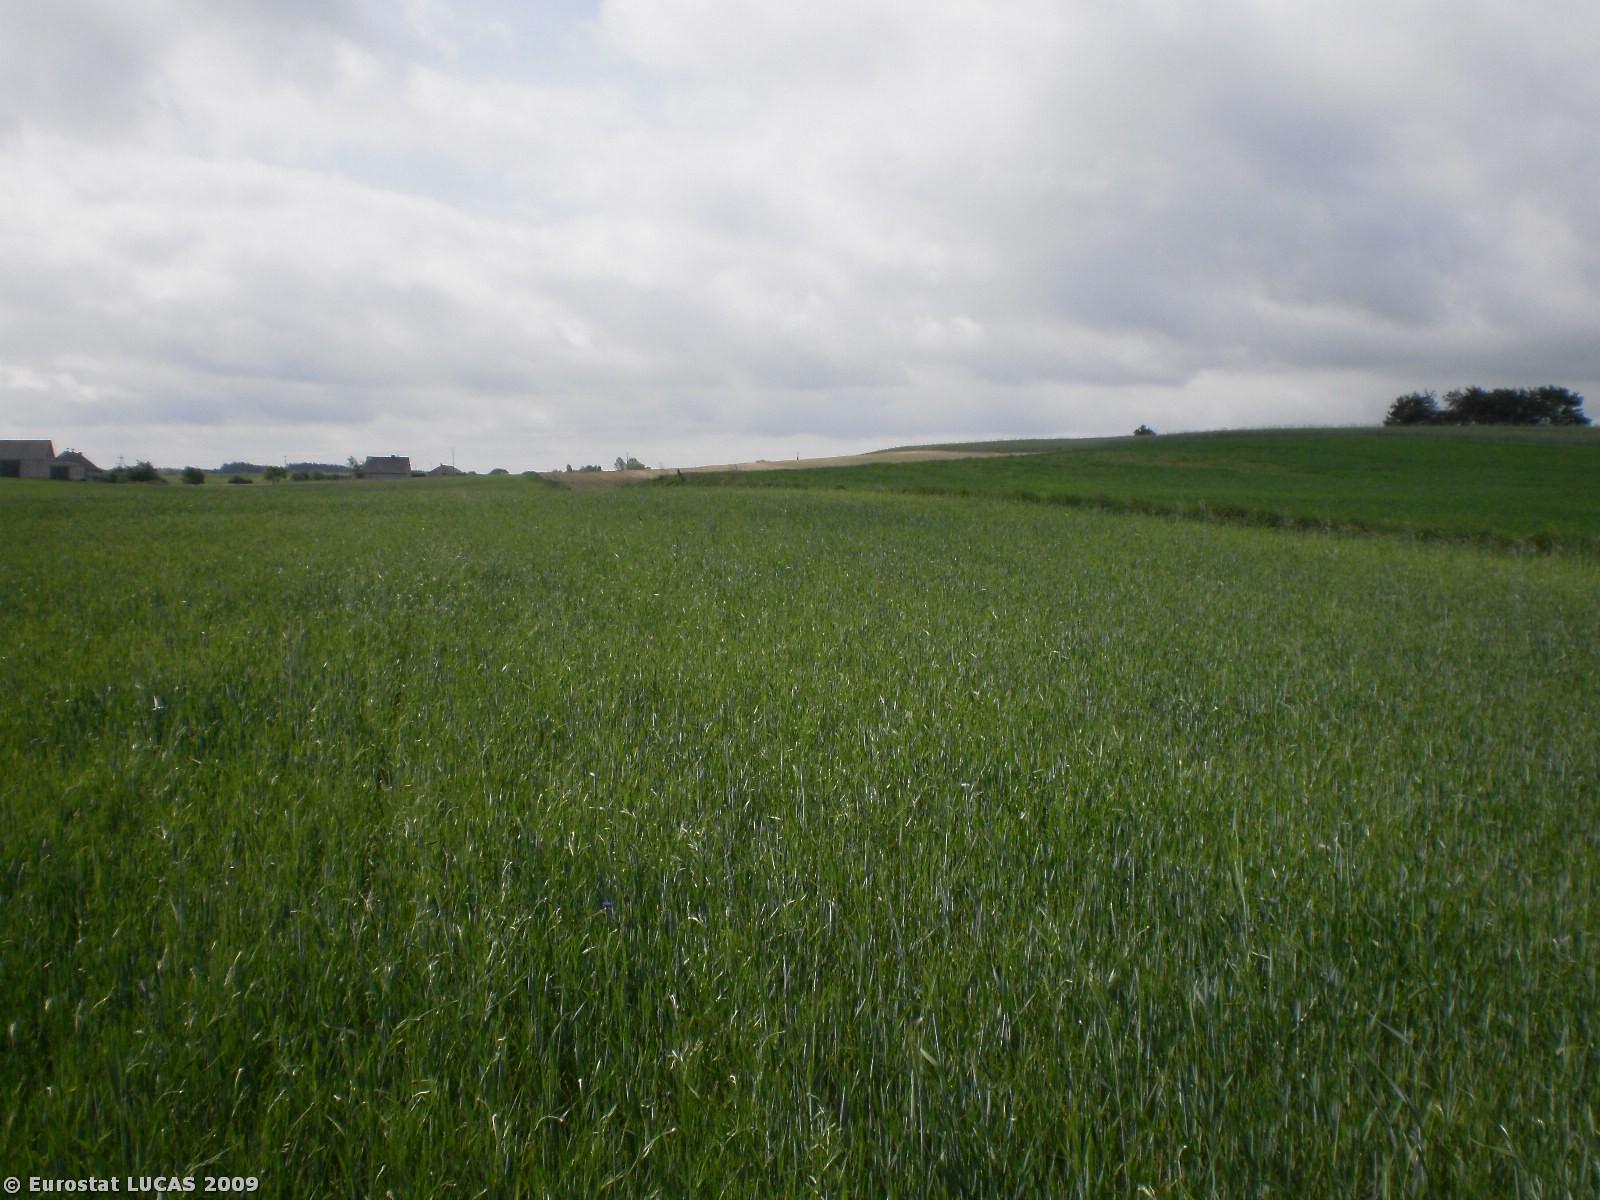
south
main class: Cropland
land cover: Rye
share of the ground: > 75 %
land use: Agriculture (excluding fallow land and kitchen gardens)
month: May
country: PL
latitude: 53.5542
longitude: 17.6960
